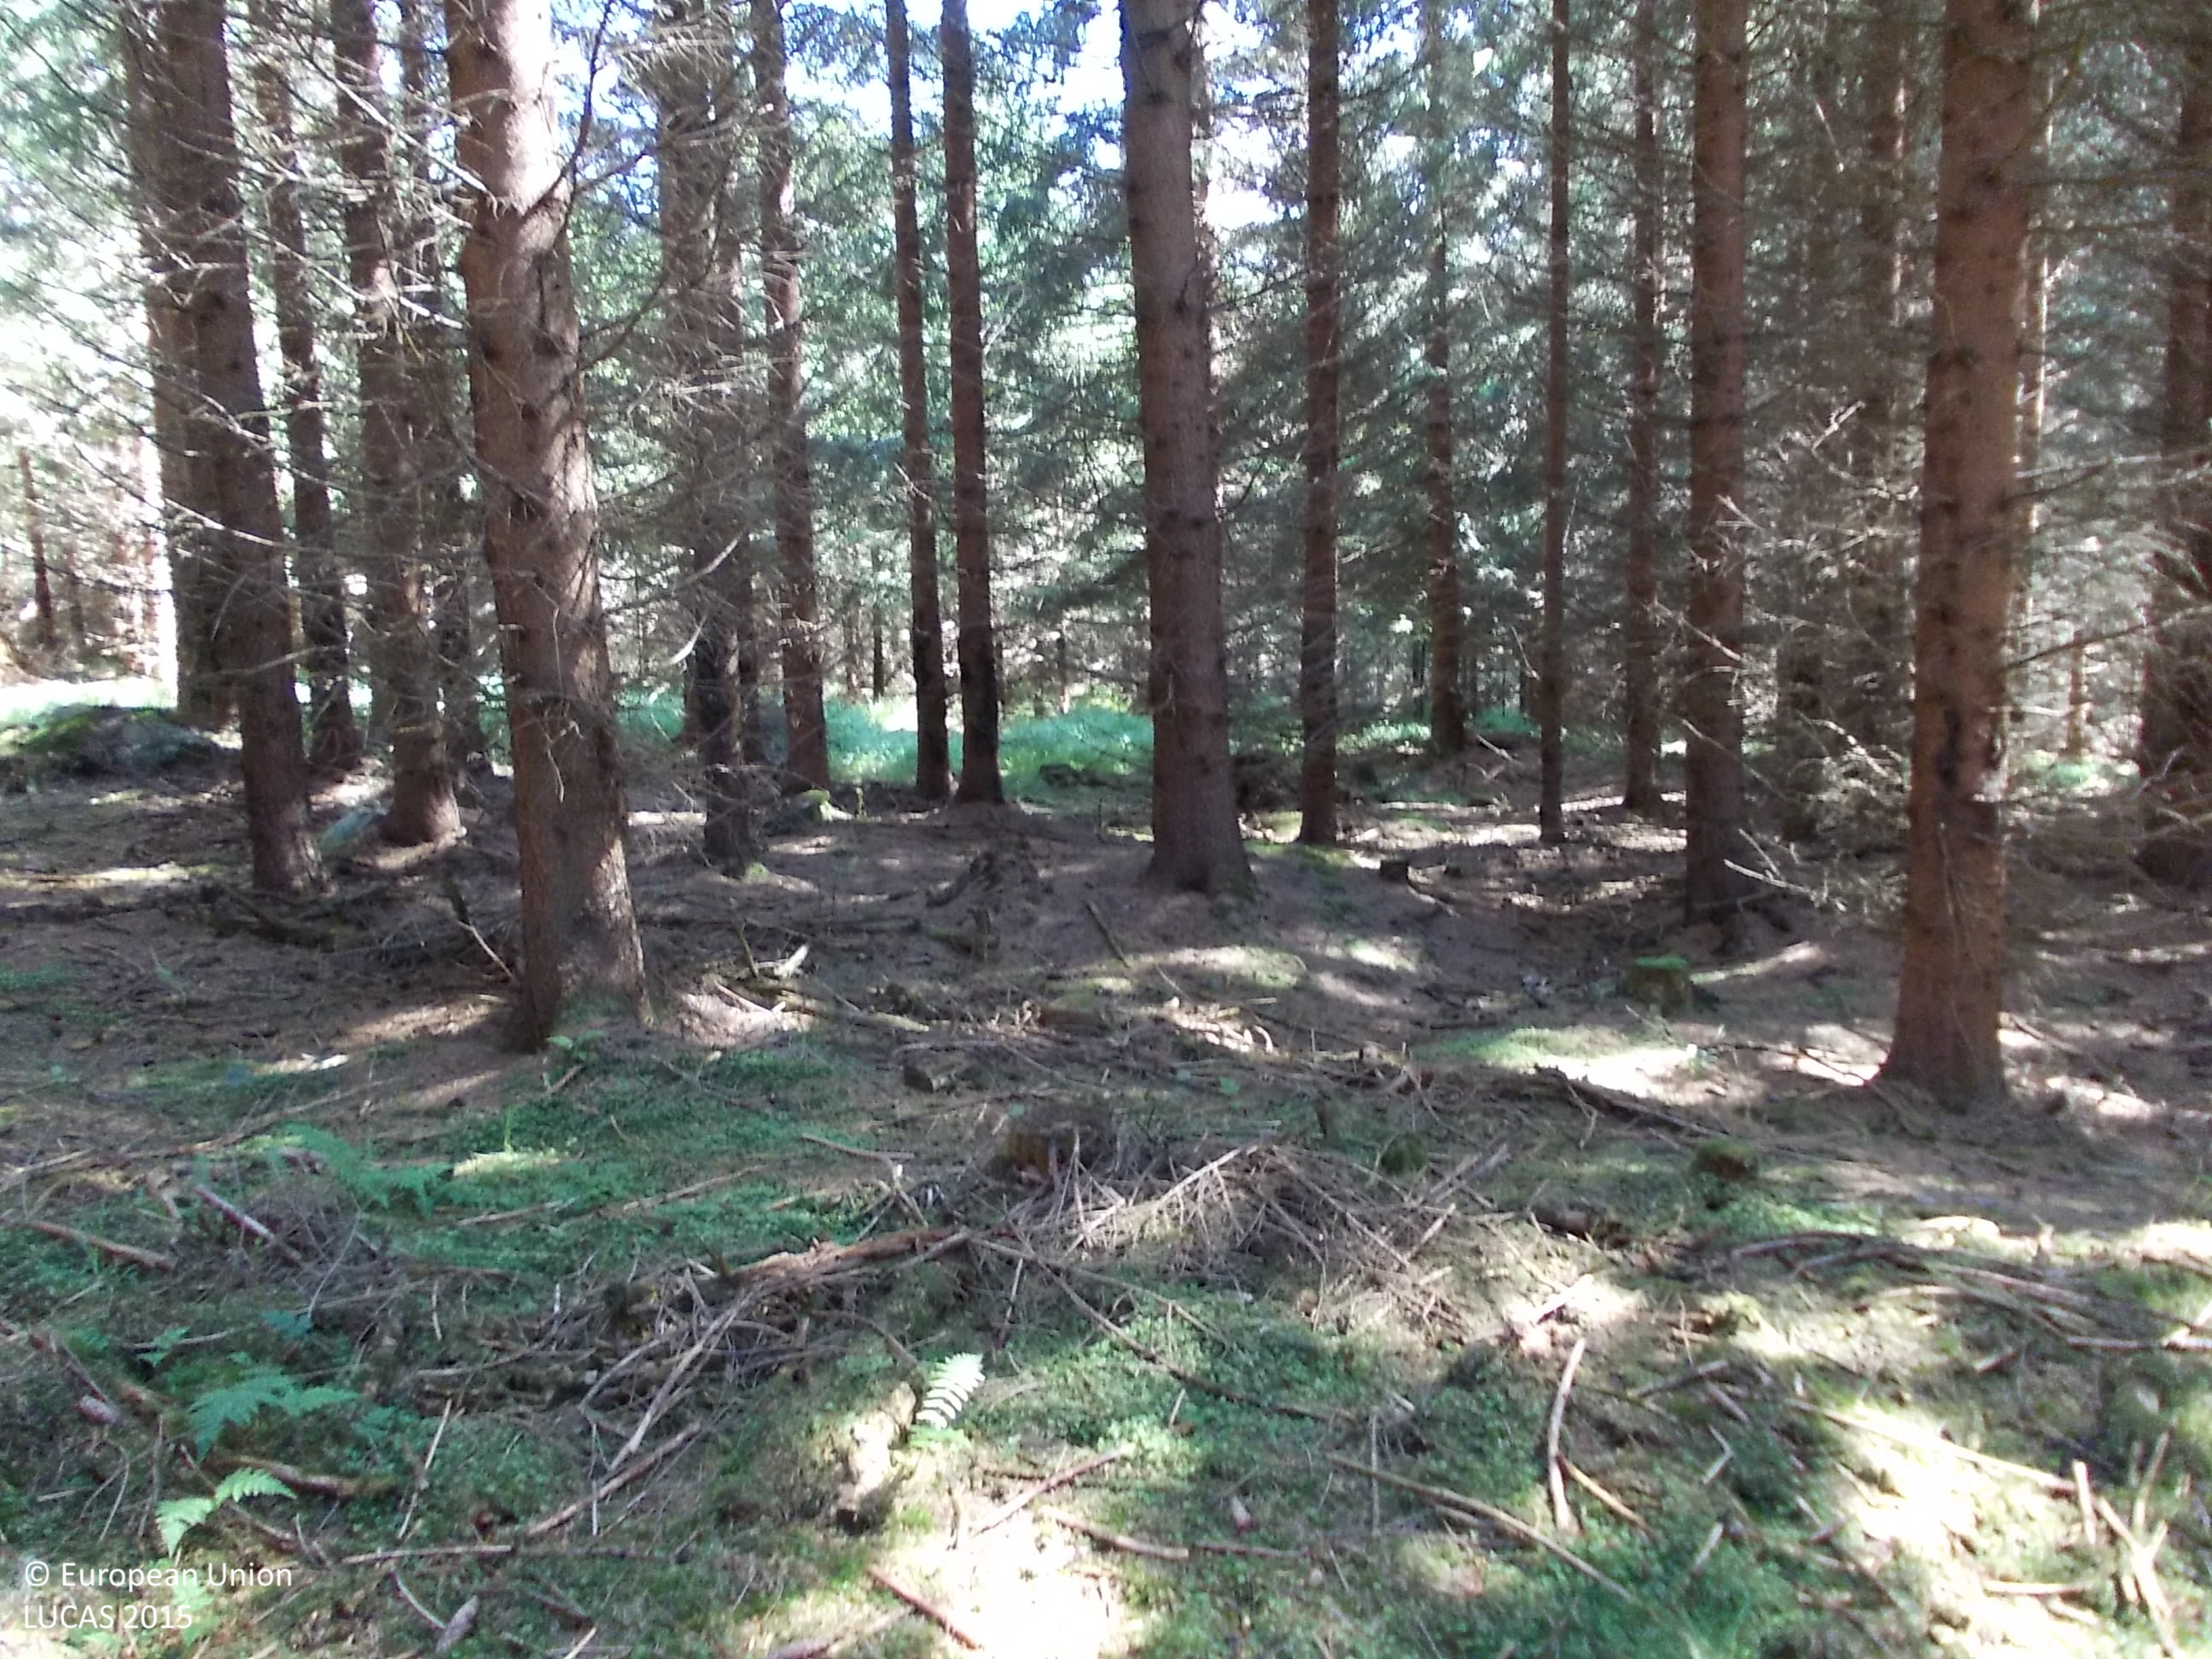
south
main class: Woodland
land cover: Spruce dominated coniferous woodland
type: hemiboreal forest and nemoral coniferous forest and mixed broadleaved-coniferous forest
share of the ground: > 75 %
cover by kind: coniferous forest trees 90 %, lichens and mosses 5 %, consolidated bare surface 5 %
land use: Forestry
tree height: > 5 m
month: June
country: CZ
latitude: 48.9719
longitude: 13.7022
